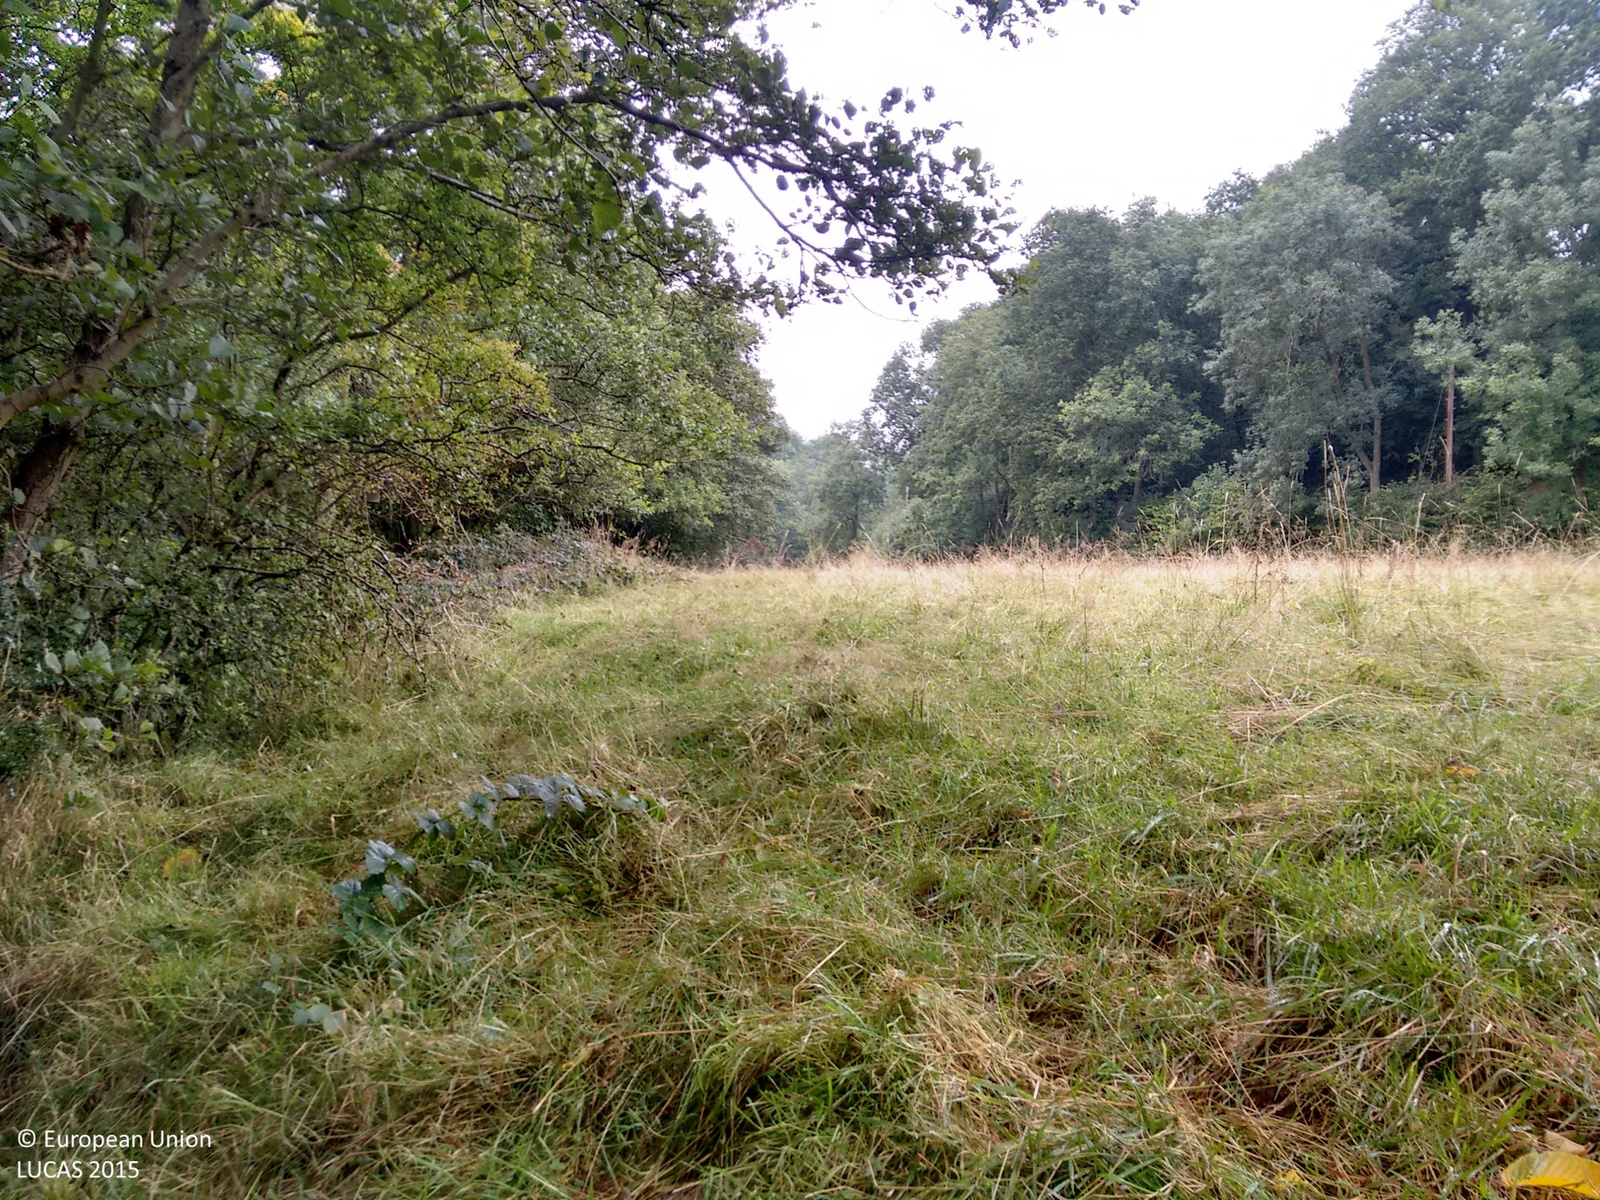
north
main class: Woodland
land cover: Other mixed woodland
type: mesophytic deciduous forest
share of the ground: > 75 %
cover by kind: broadleaved forest trees 60 %, coniferous forest trees 40 %
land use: Forestry
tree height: > 5 m
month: September
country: GB
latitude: 52.5425
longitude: -2.9164
